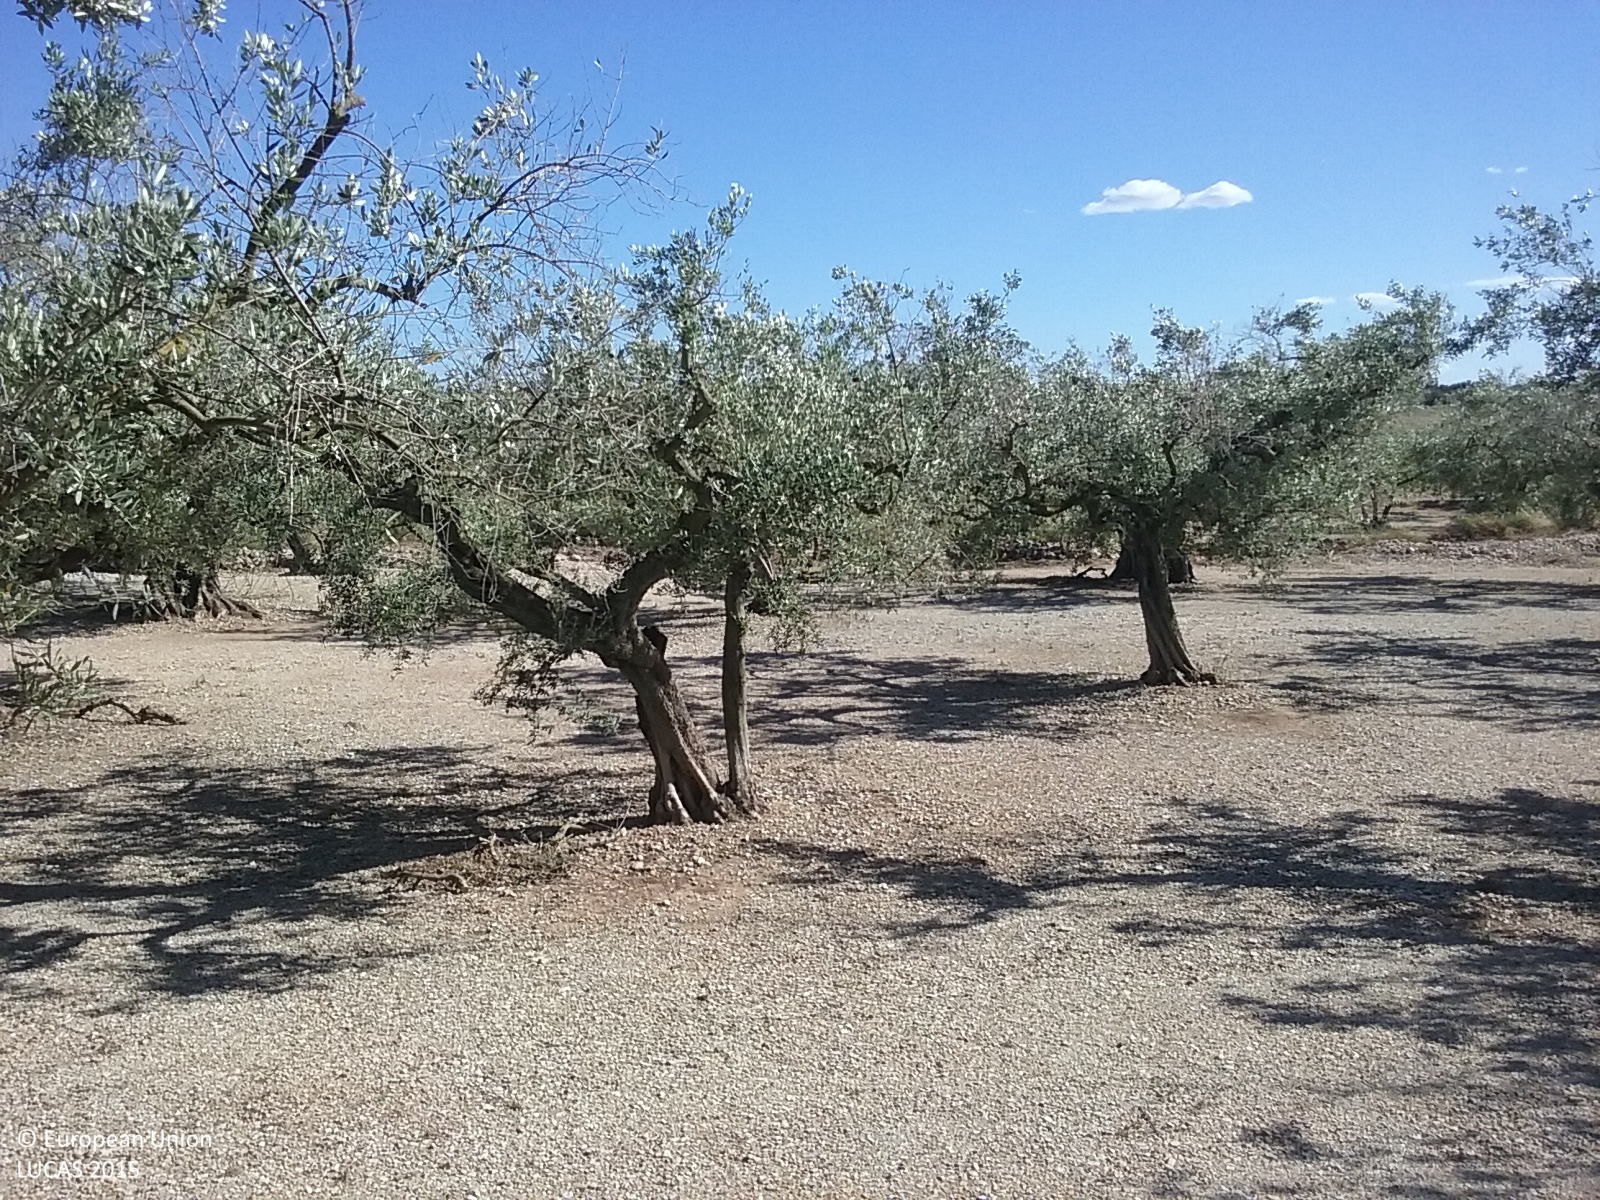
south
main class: Cropland
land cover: Olive groves
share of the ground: 50 - 75 %
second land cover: Other bare soil
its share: > 75 %
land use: Agriculture (excluding fallow land and kitchen gardens)
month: May
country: ES
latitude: 40.7816
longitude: 0.4312
